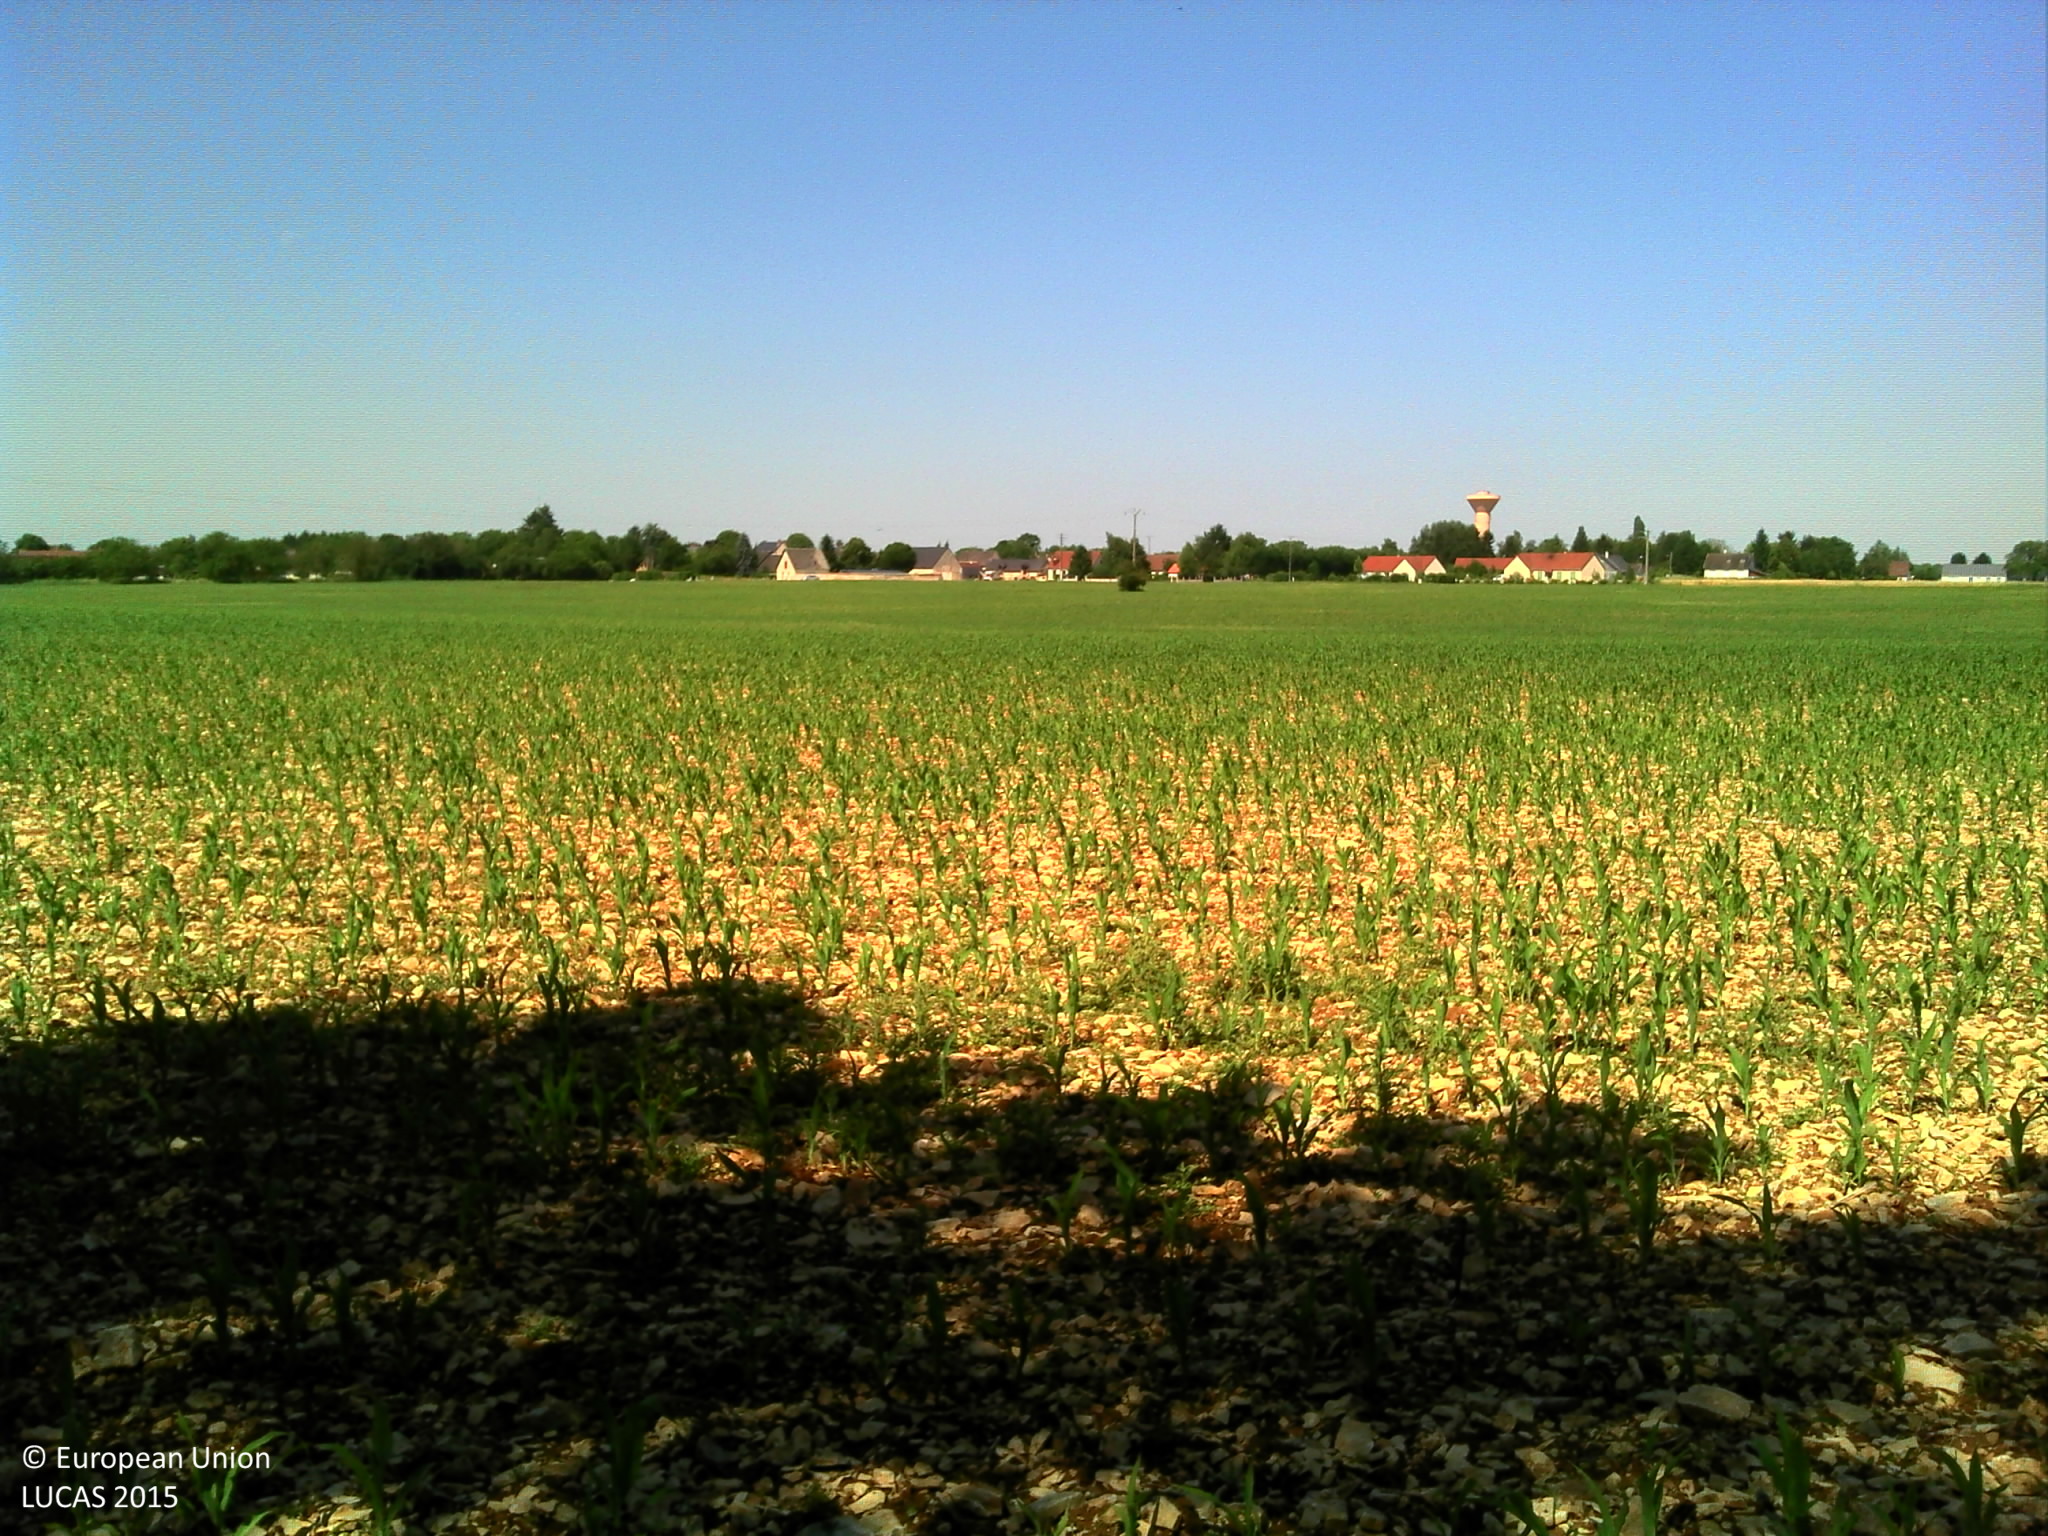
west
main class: Woodland
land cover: Broadleaved woodland
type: acidophilous oak and oak-birch forest
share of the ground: > 75 %
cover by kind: broadleaved forest trees 95 %, shrubs 5 %
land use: Forestry
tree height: > 5 m
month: June
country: FR
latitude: 47.0750
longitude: 2.6585
